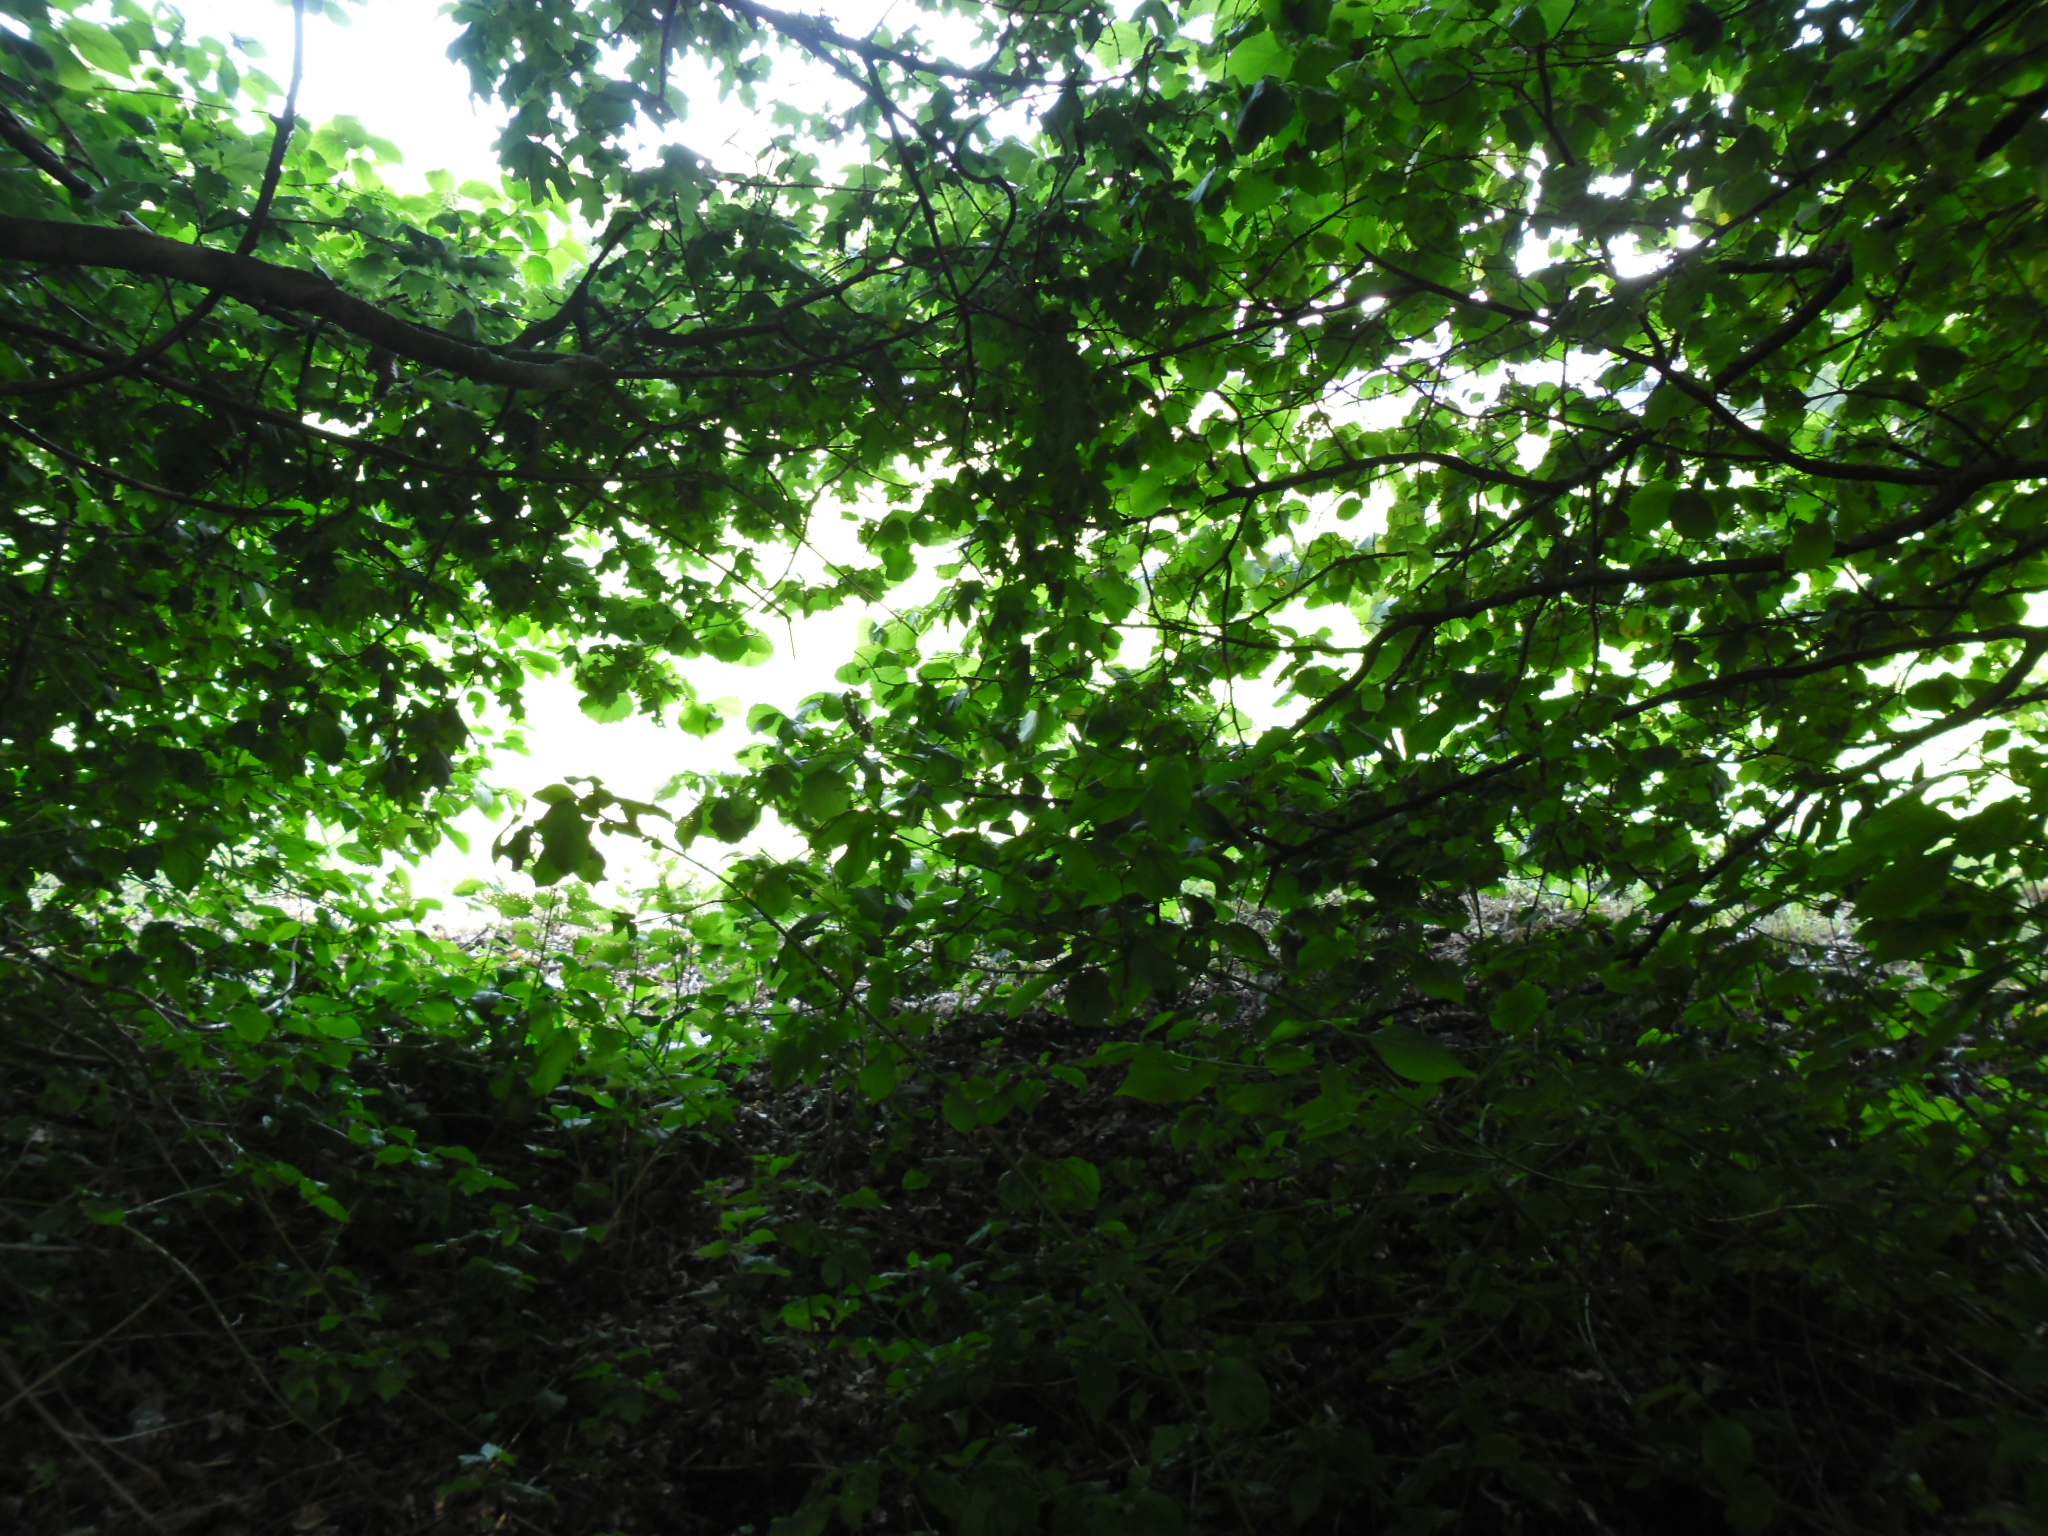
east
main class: Woodland
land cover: Broadleaved woodland
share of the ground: > 75 %
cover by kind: broadleaved forest trees 100 %
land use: Amenities, museums, leisure
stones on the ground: < 10 %
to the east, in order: Broadleaved woodland; Grassland without tree/shrub cover; Other bare soil; Grassland without tree/shrub cover; Floriculture and ornamental plants; Artificial constructions in urban areas
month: June
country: NL
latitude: 52.5253
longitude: 5.4734
